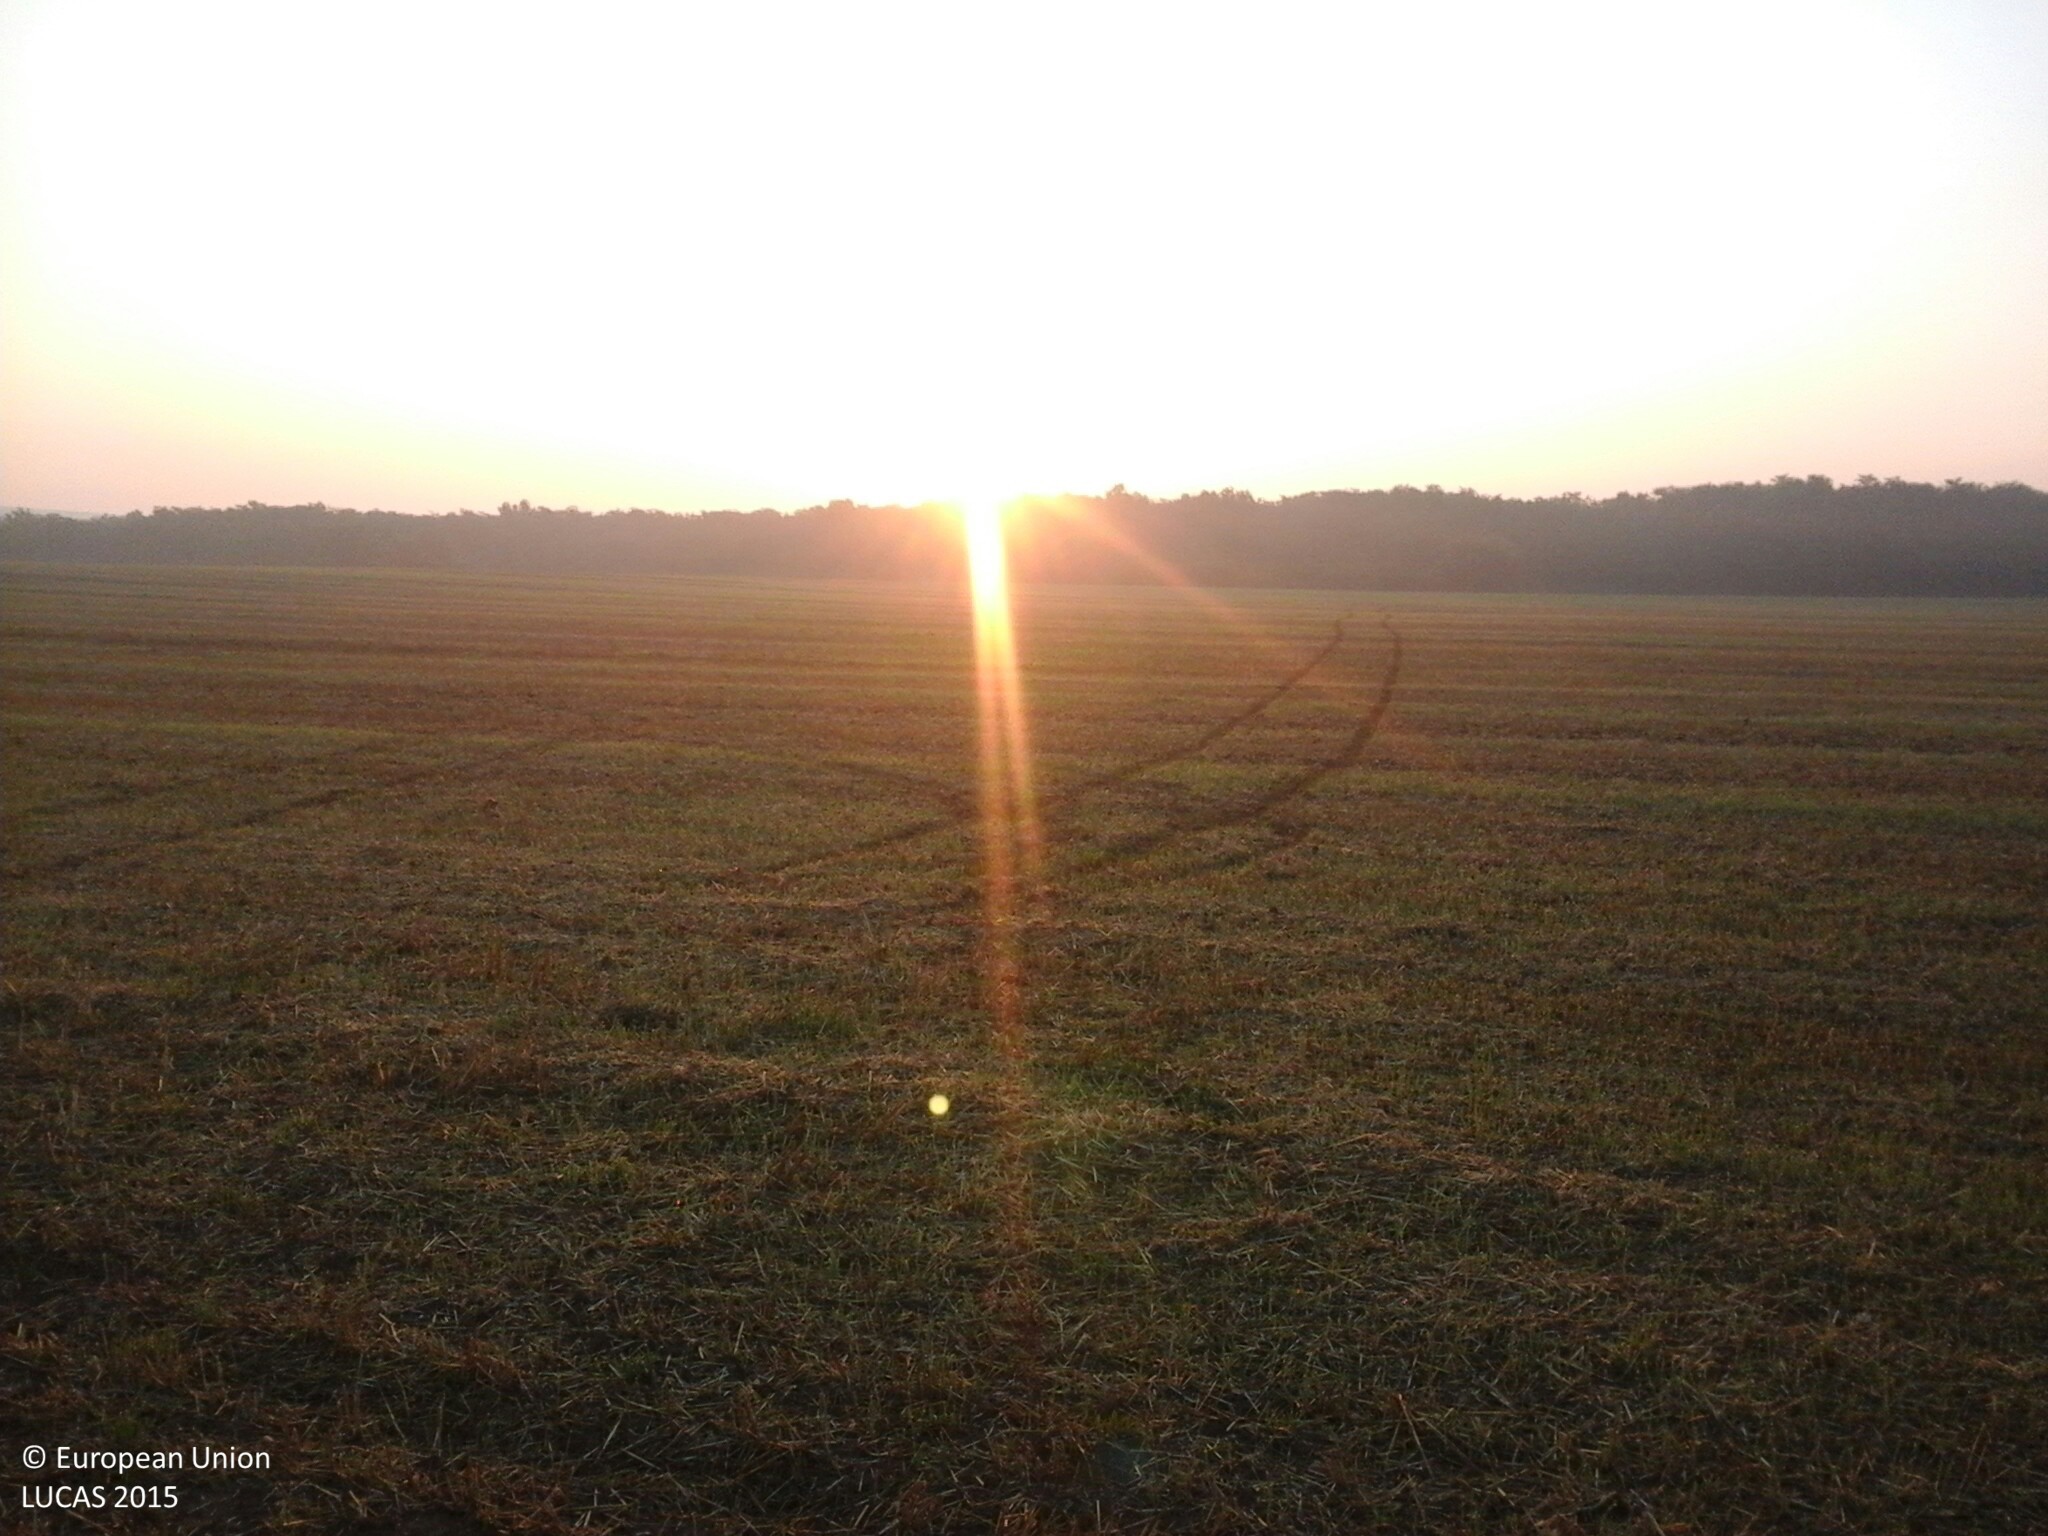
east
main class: Cropland
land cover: Common wheat
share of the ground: 50 - 75 %
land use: Agriculture (excluding fallow land and kitchen gardens)
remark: Harvested field
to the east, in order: Common wheat
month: August
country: HU
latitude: 47.5272
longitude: 18.3407
